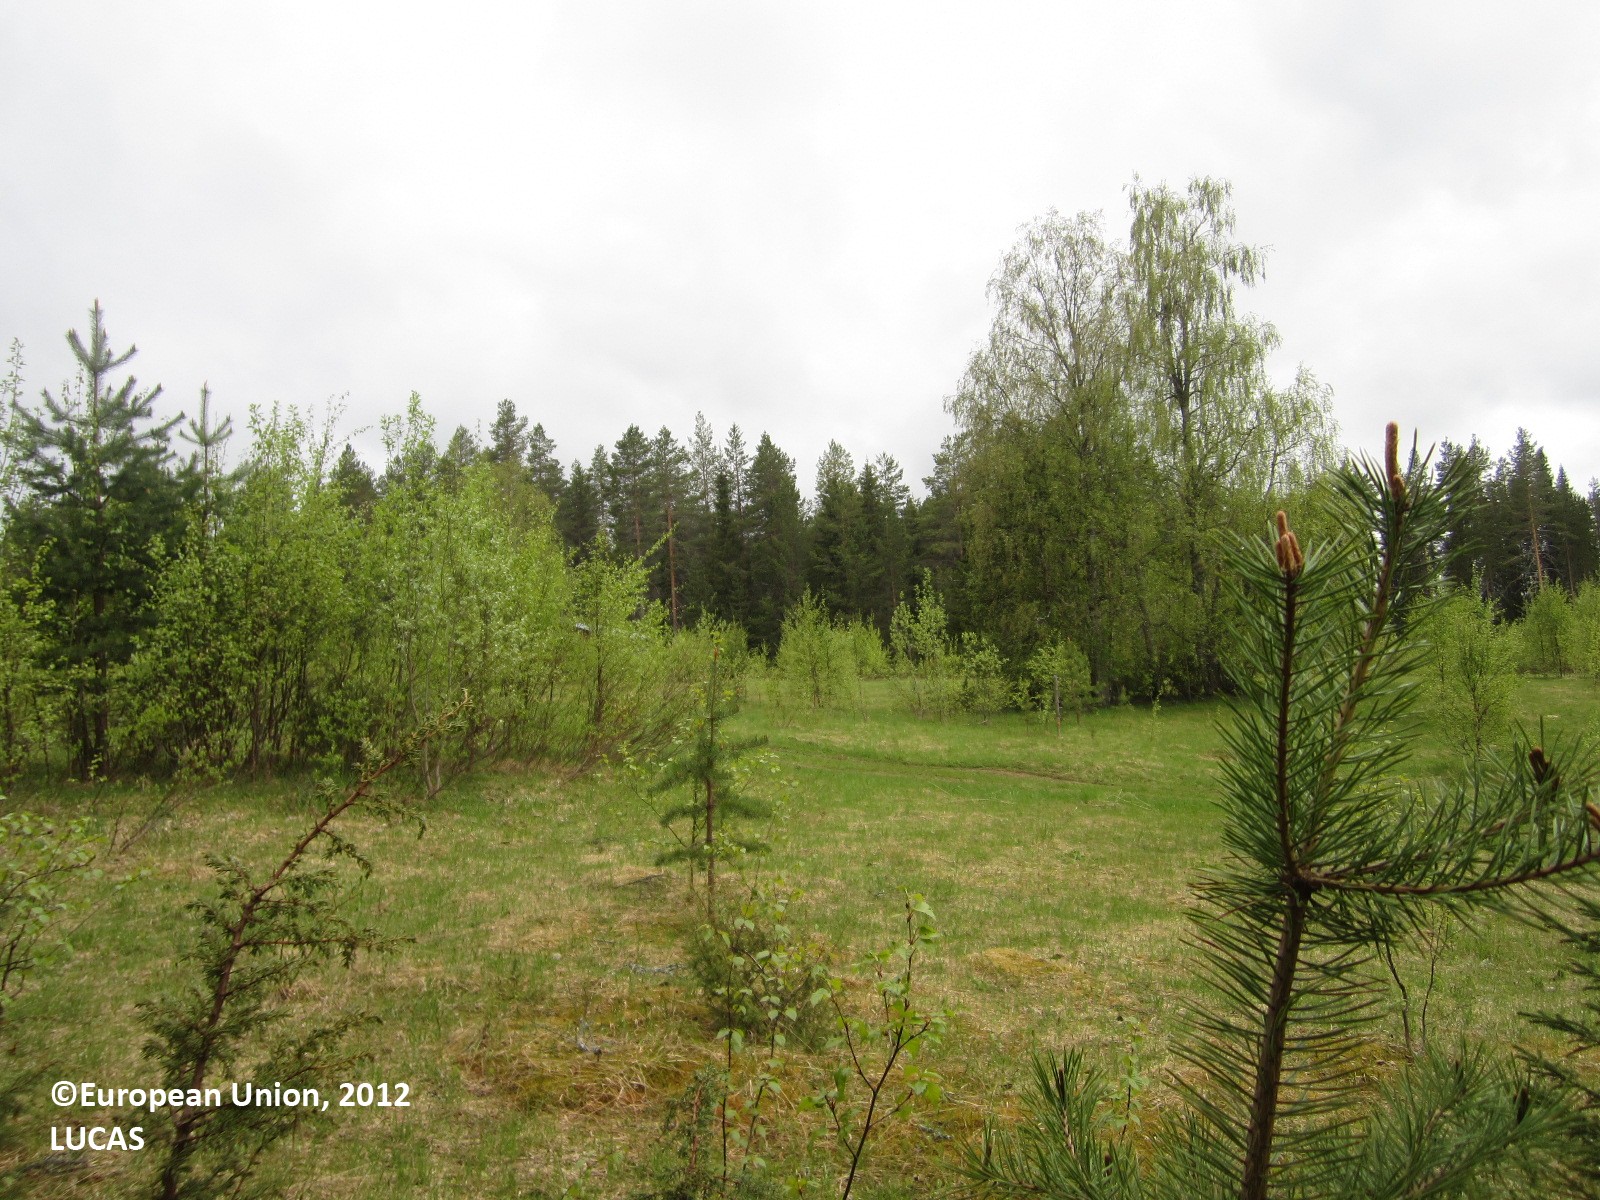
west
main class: Woodland
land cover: Pine dominated mixed woodland
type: boreal forest
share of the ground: > 75 %
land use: Forestry
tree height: > 5 m
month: June
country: FI
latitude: 64.7728
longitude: 28.7926
